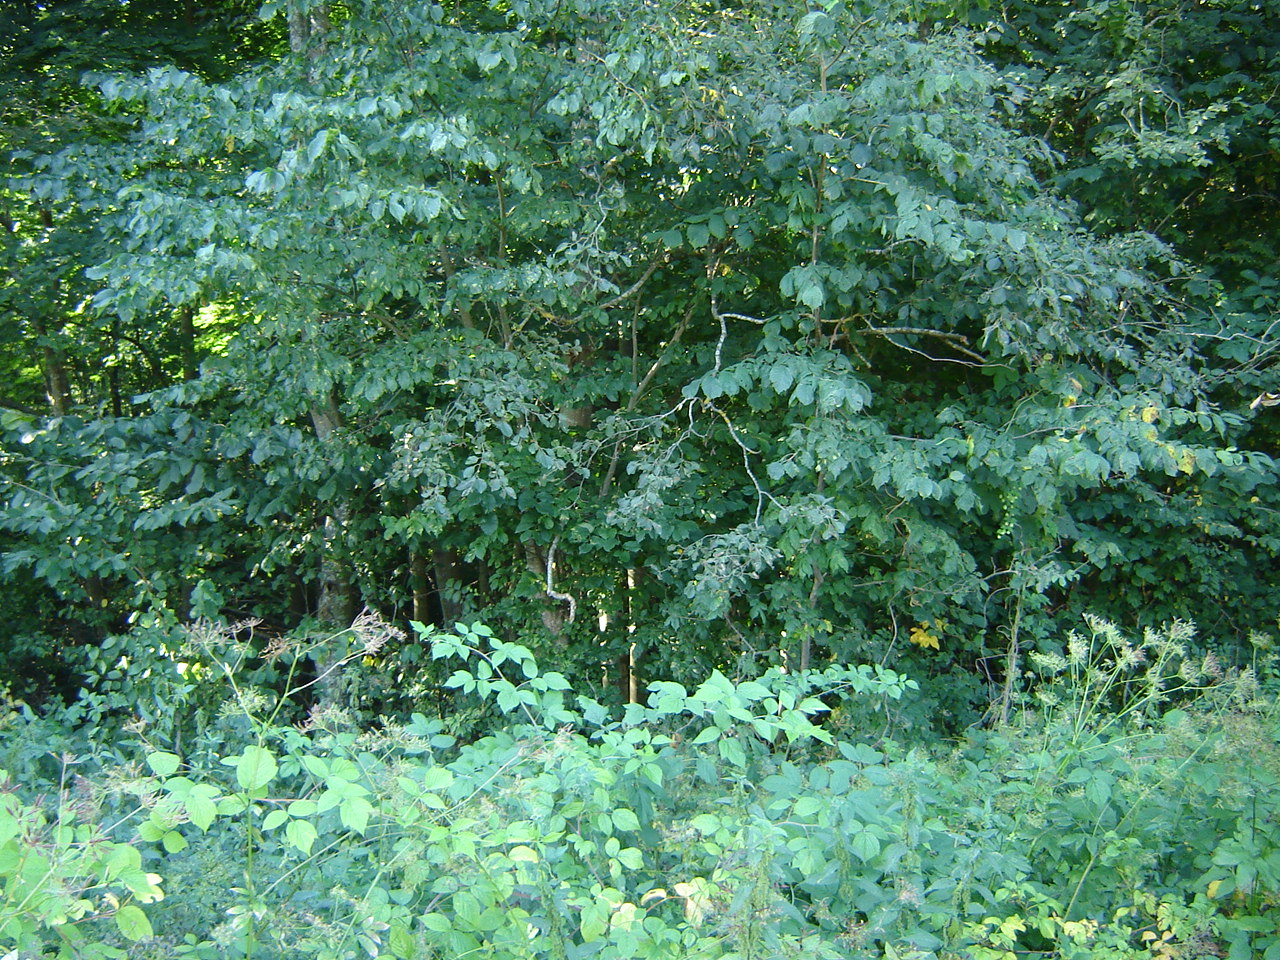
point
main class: Woodland
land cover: Broadleaved woodland
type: non-riverine alder, birch or aspen forest
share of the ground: > 75 %
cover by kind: broadleaved forest trees 90 %, herbaceous plants 10 %
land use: Forestry
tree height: > 5 m
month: August
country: LT
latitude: 54.8610
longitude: 24.8321
